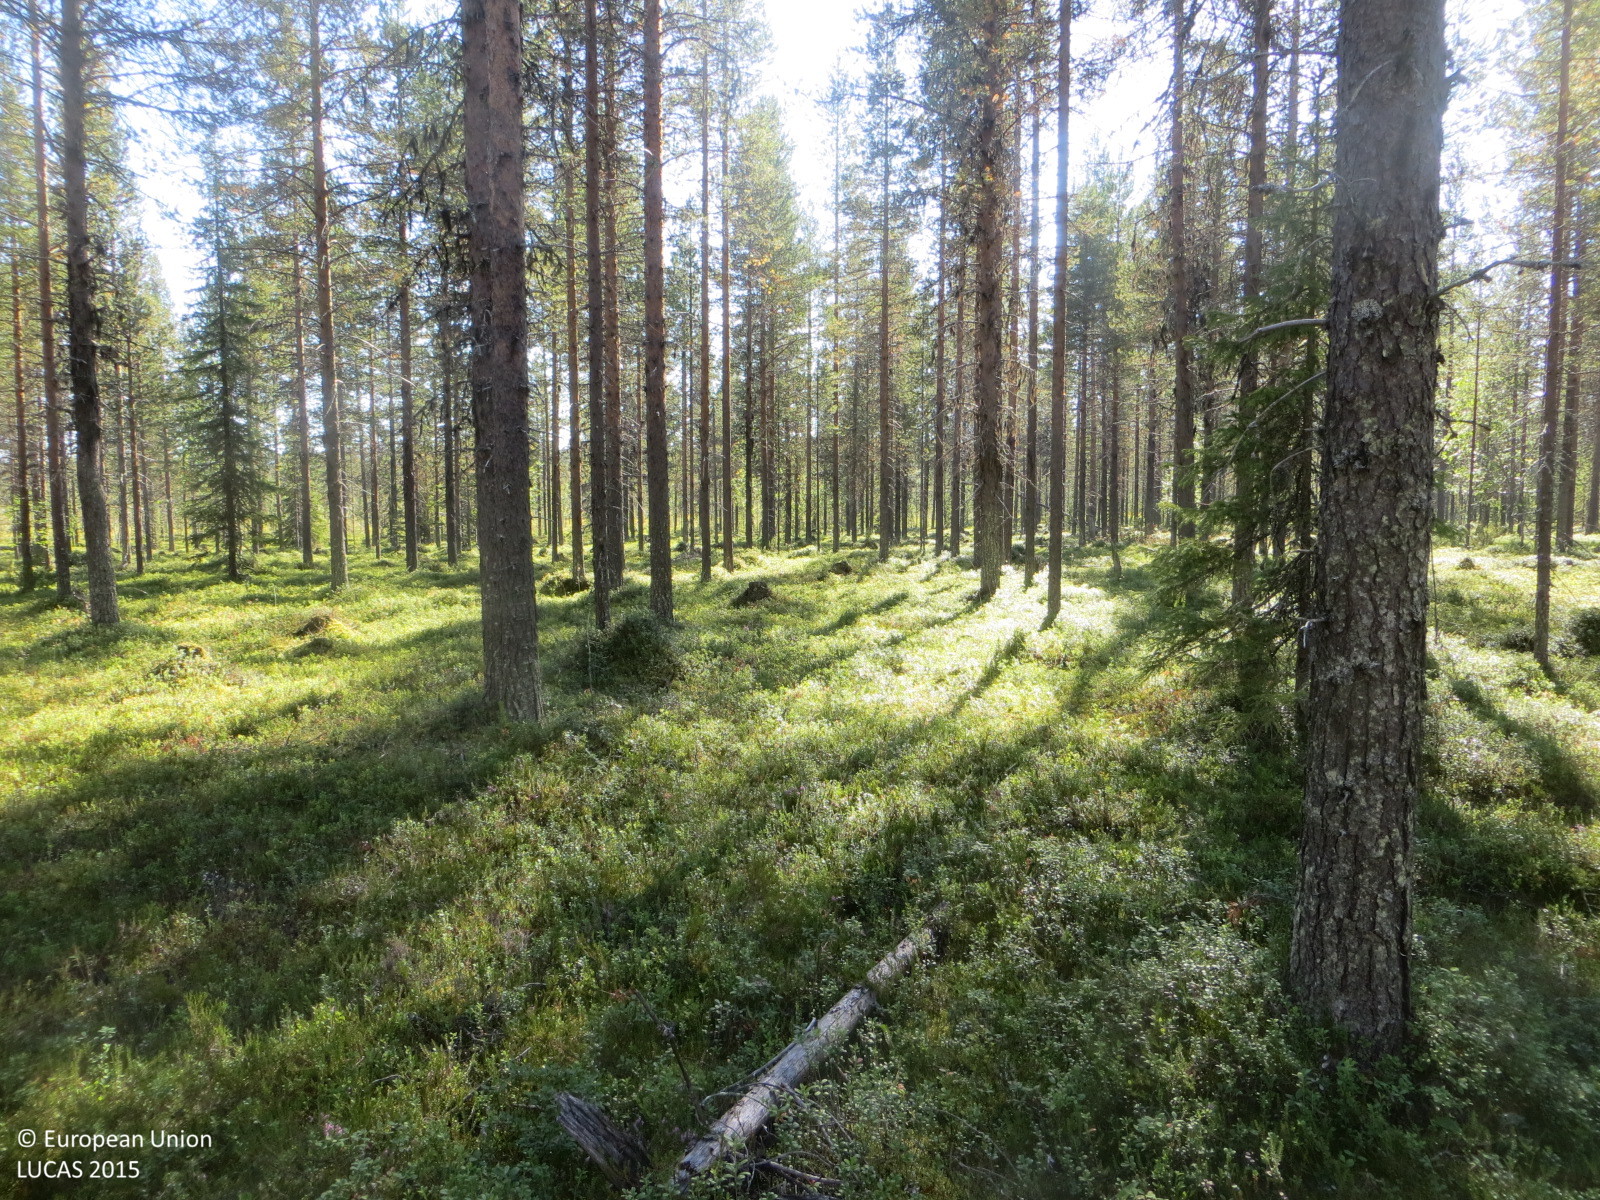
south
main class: Woodland
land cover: Pine dominated coniferous woodland
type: boreal forest
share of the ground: 50 - 75 %
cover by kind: coniferous forest trees 50 %, shrubs 50 %
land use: Forestry
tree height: > 5 m
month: August
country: FI
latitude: 67.5234
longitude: 23.9211
